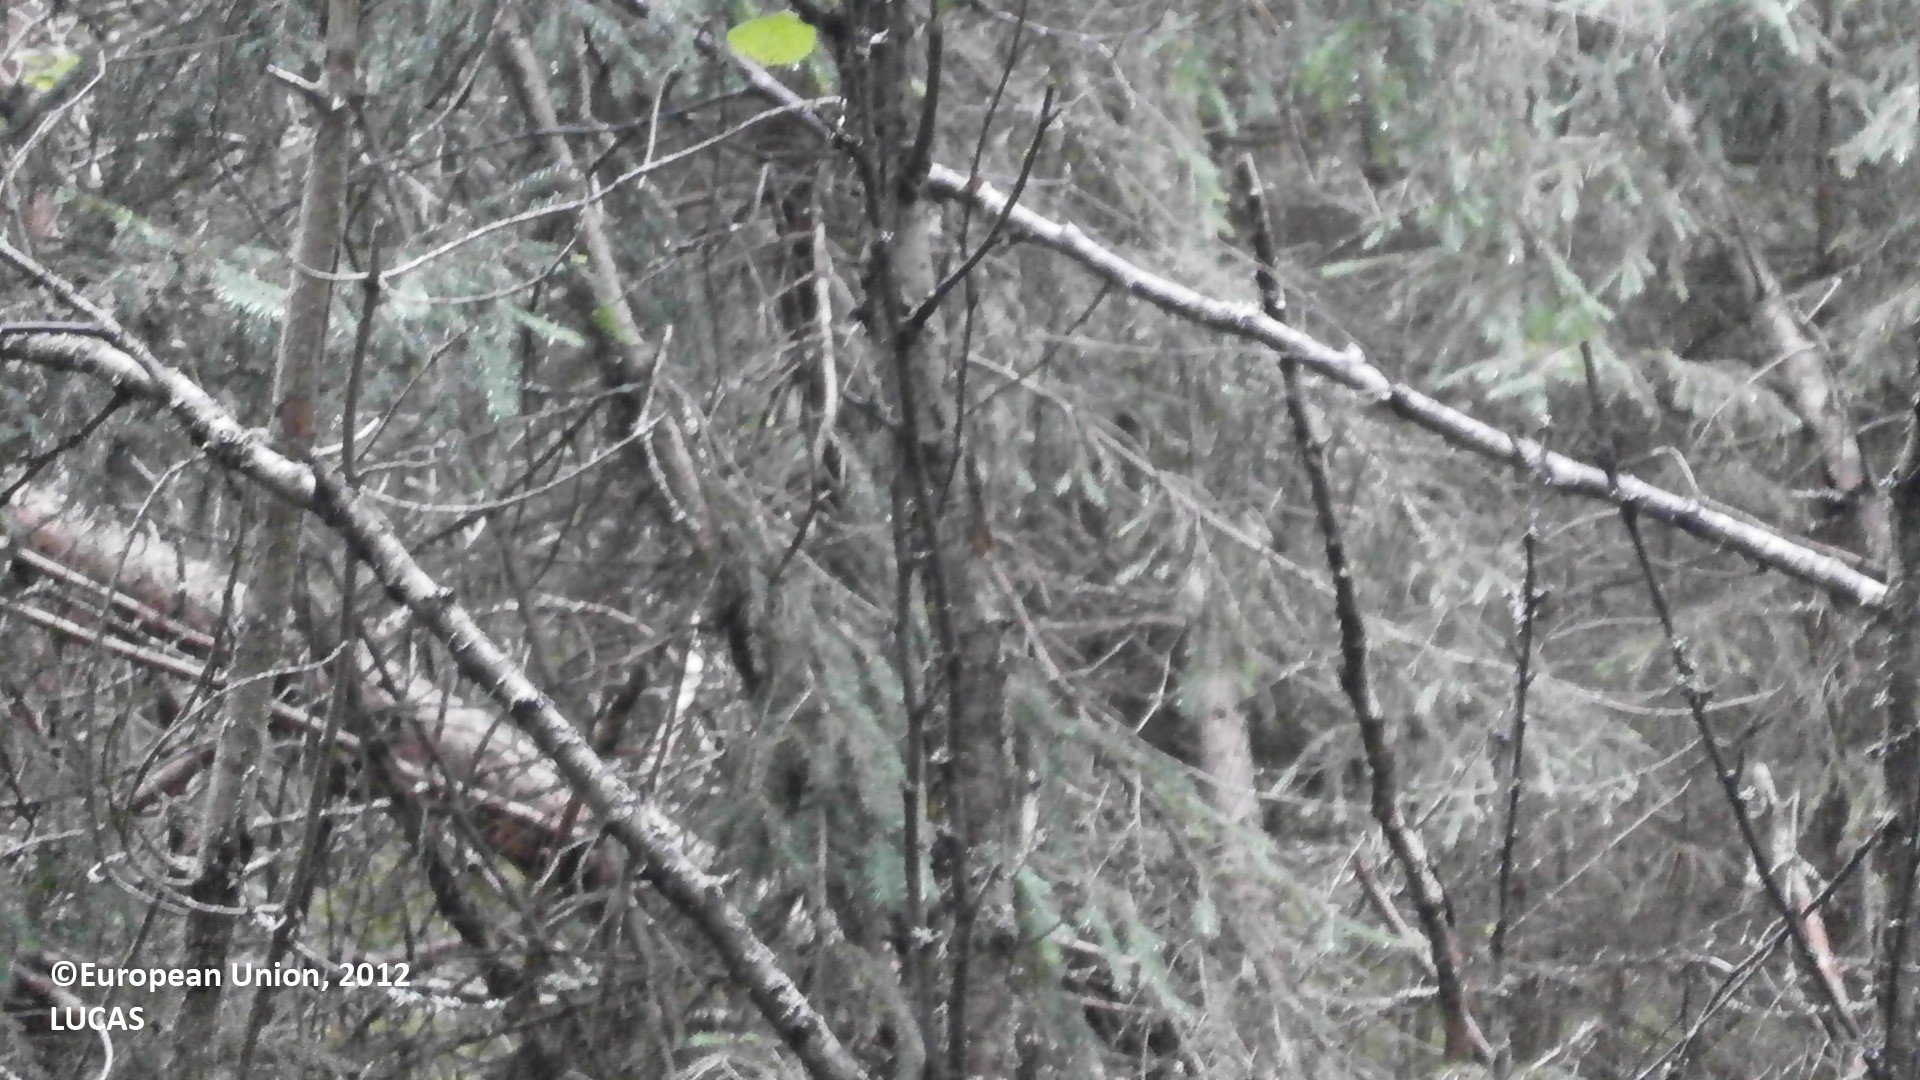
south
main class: Woodland
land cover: Pine dominated mixed woodland
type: boreal forest
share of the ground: > 75 %
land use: Forestry
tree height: > 5 m
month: July
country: FI
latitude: 64.7443
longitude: 24.6688
